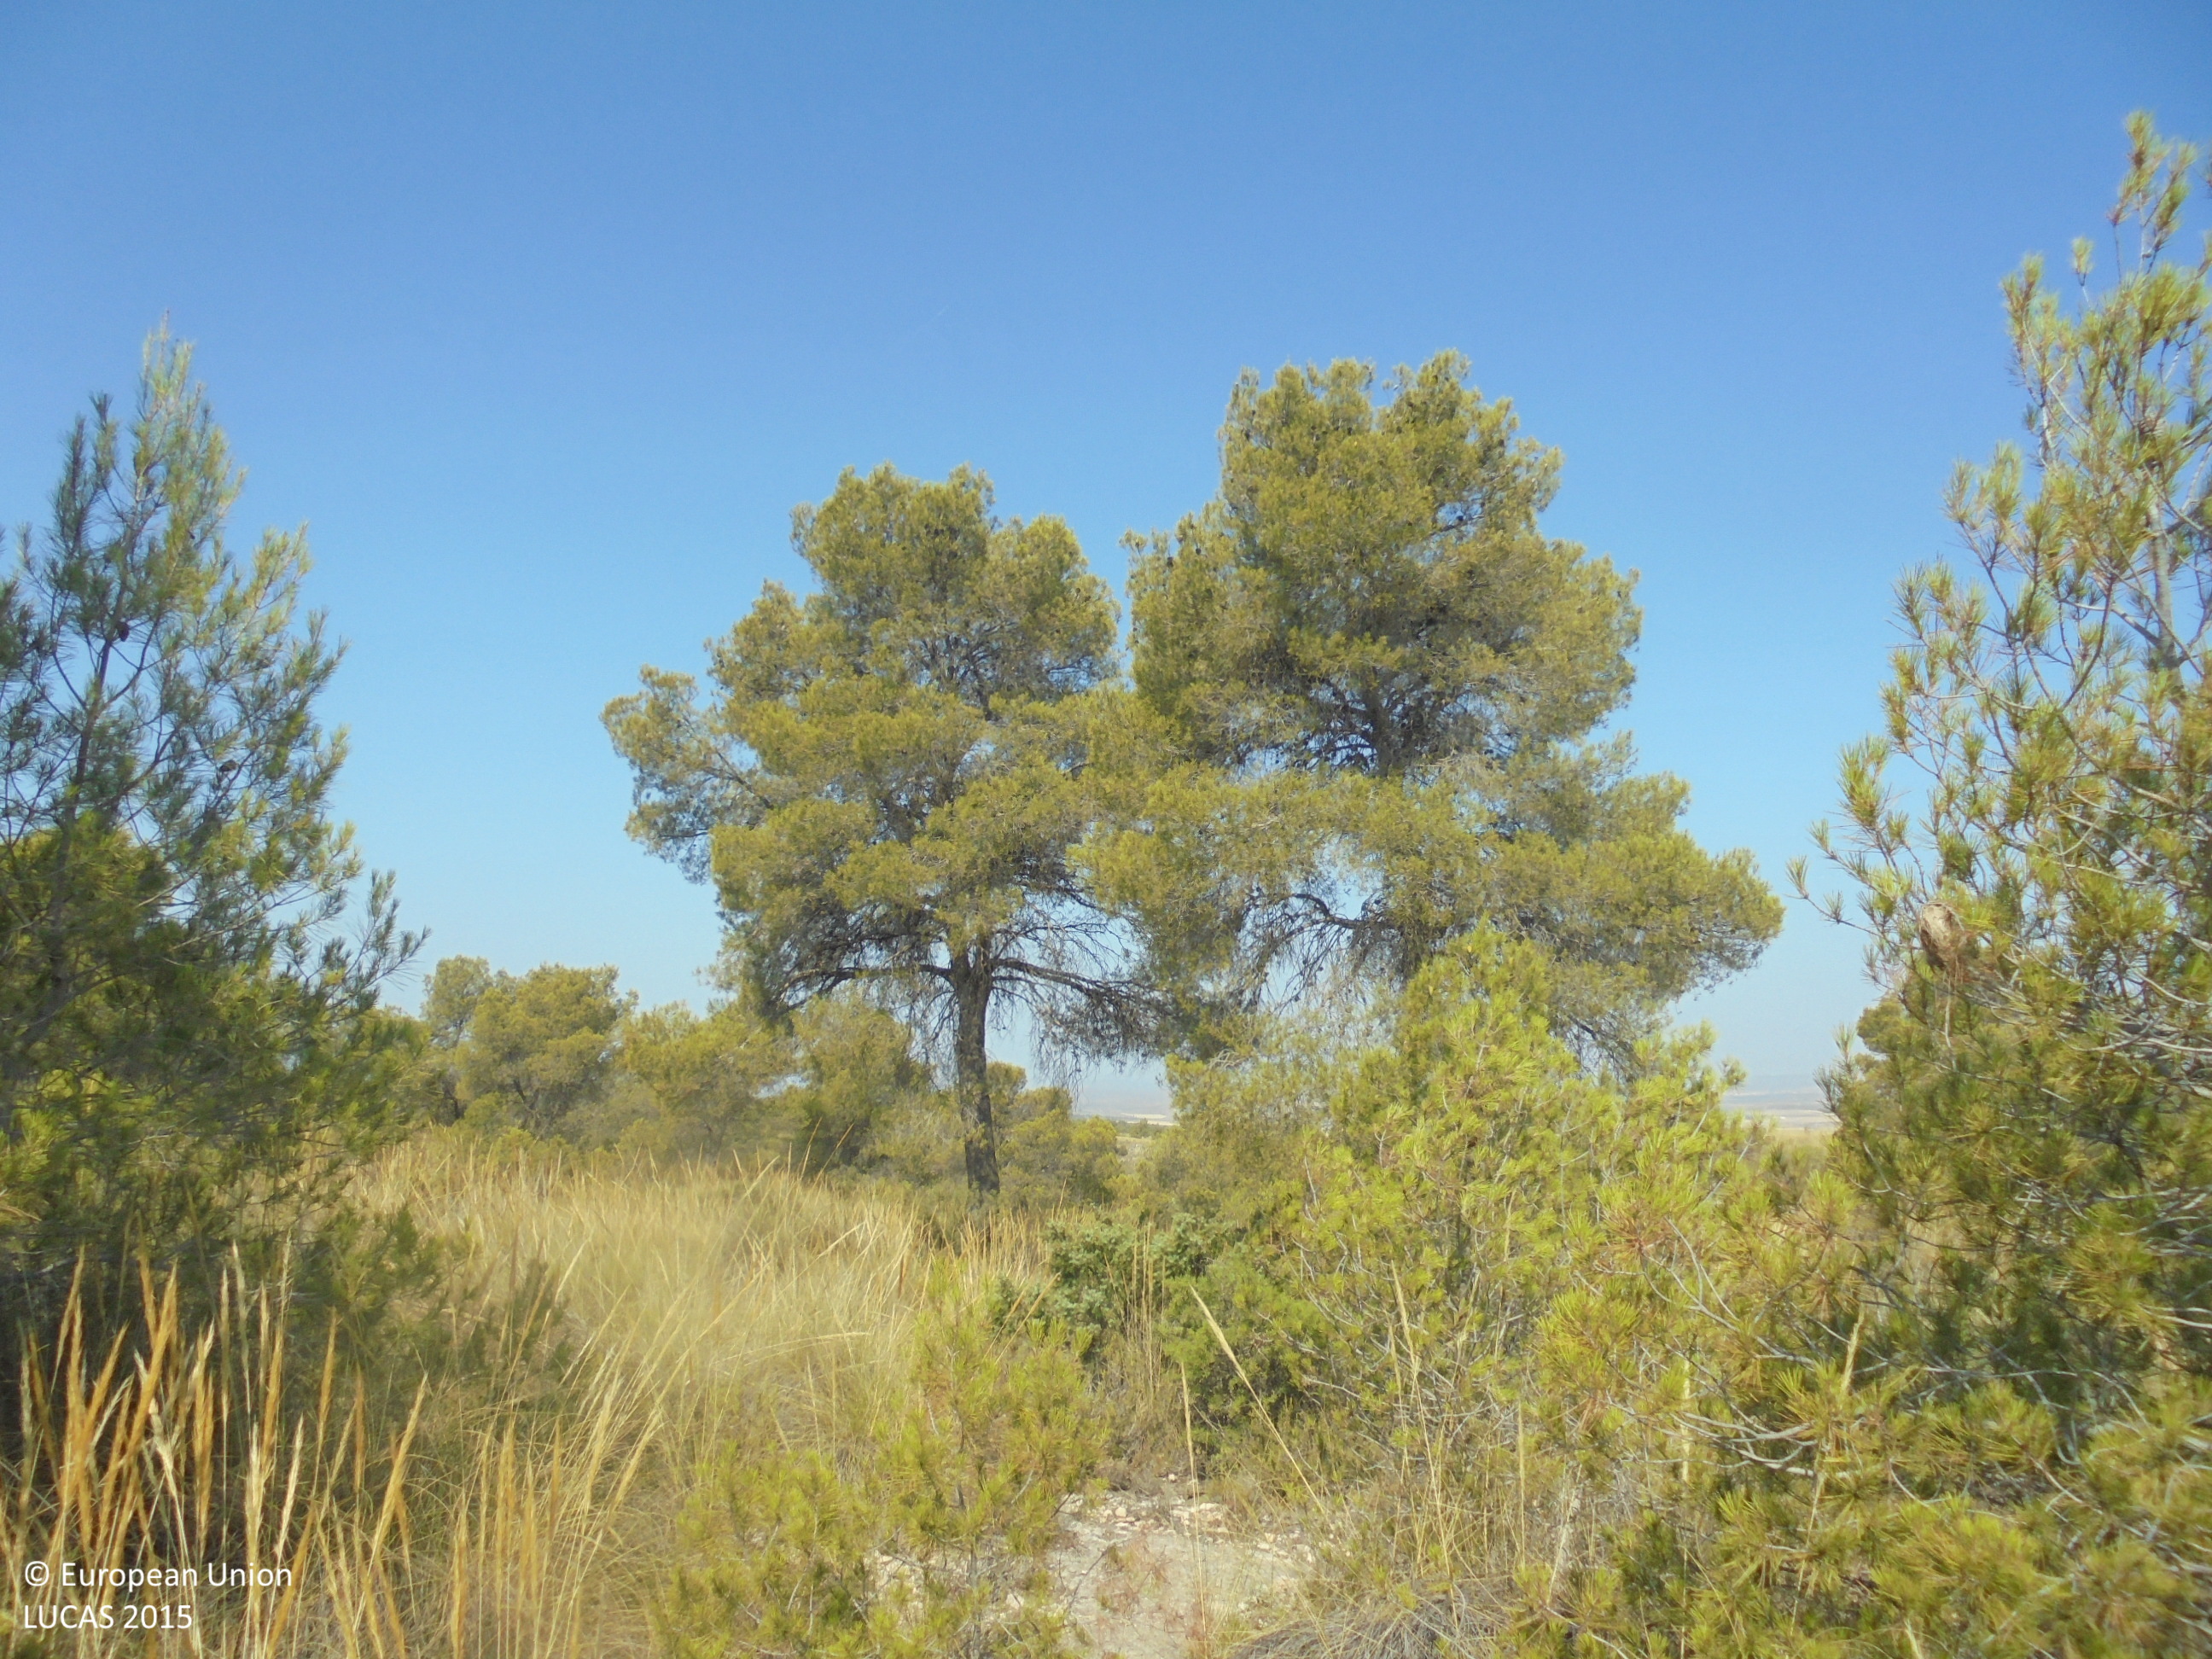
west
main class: Woodland
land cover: Pine dominated coniferous woodland
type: coniferous forest of the mediterranean region
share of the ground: 25 - 50 %
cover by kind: coniferous forest trees 45 %, shrubs 35 %, unconsolidated bare surface 20 %
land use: Semi-natural and natural areas not in use
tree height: > 5 m
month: July
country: ES
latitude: 38.5348
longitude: -1.4526
